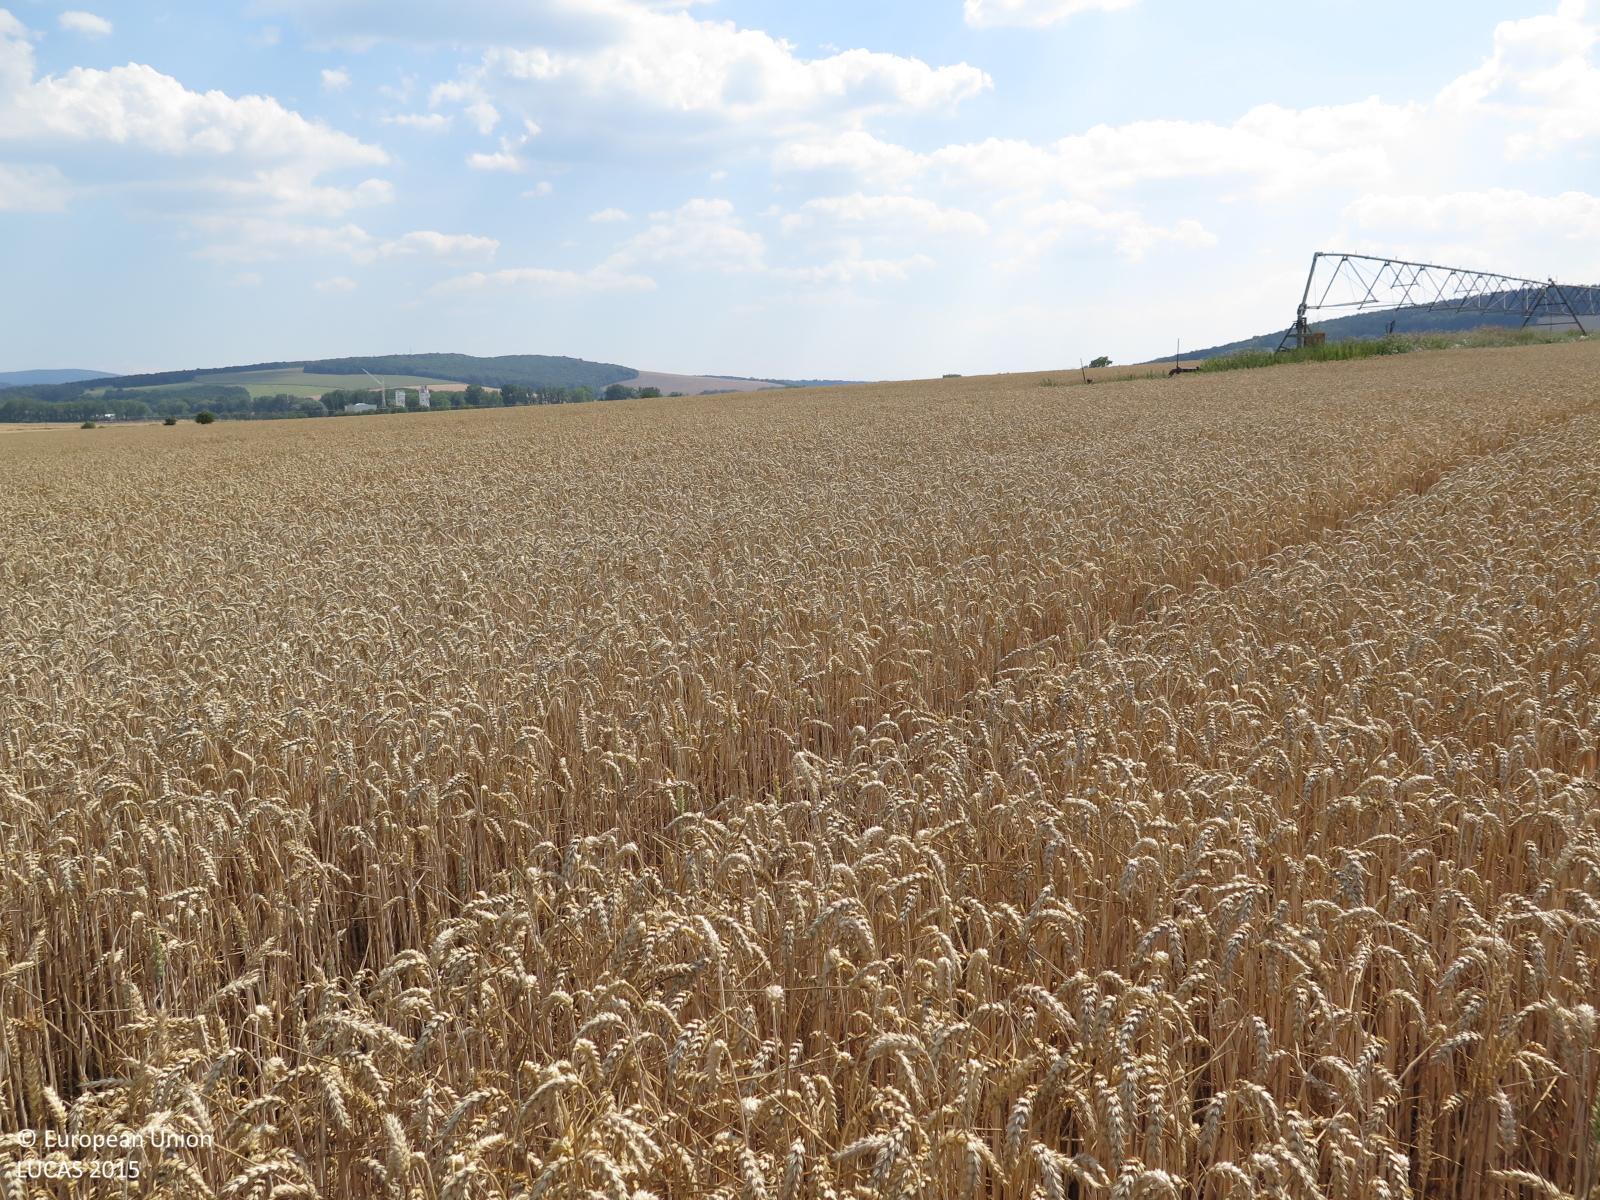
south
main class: Cropland
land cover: Common wheat
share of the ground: > 75 %
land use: Agriculture (excluding fallow land and kitchen gardens)
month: July
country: CZ
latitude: 48.9770
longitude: 17.5397
